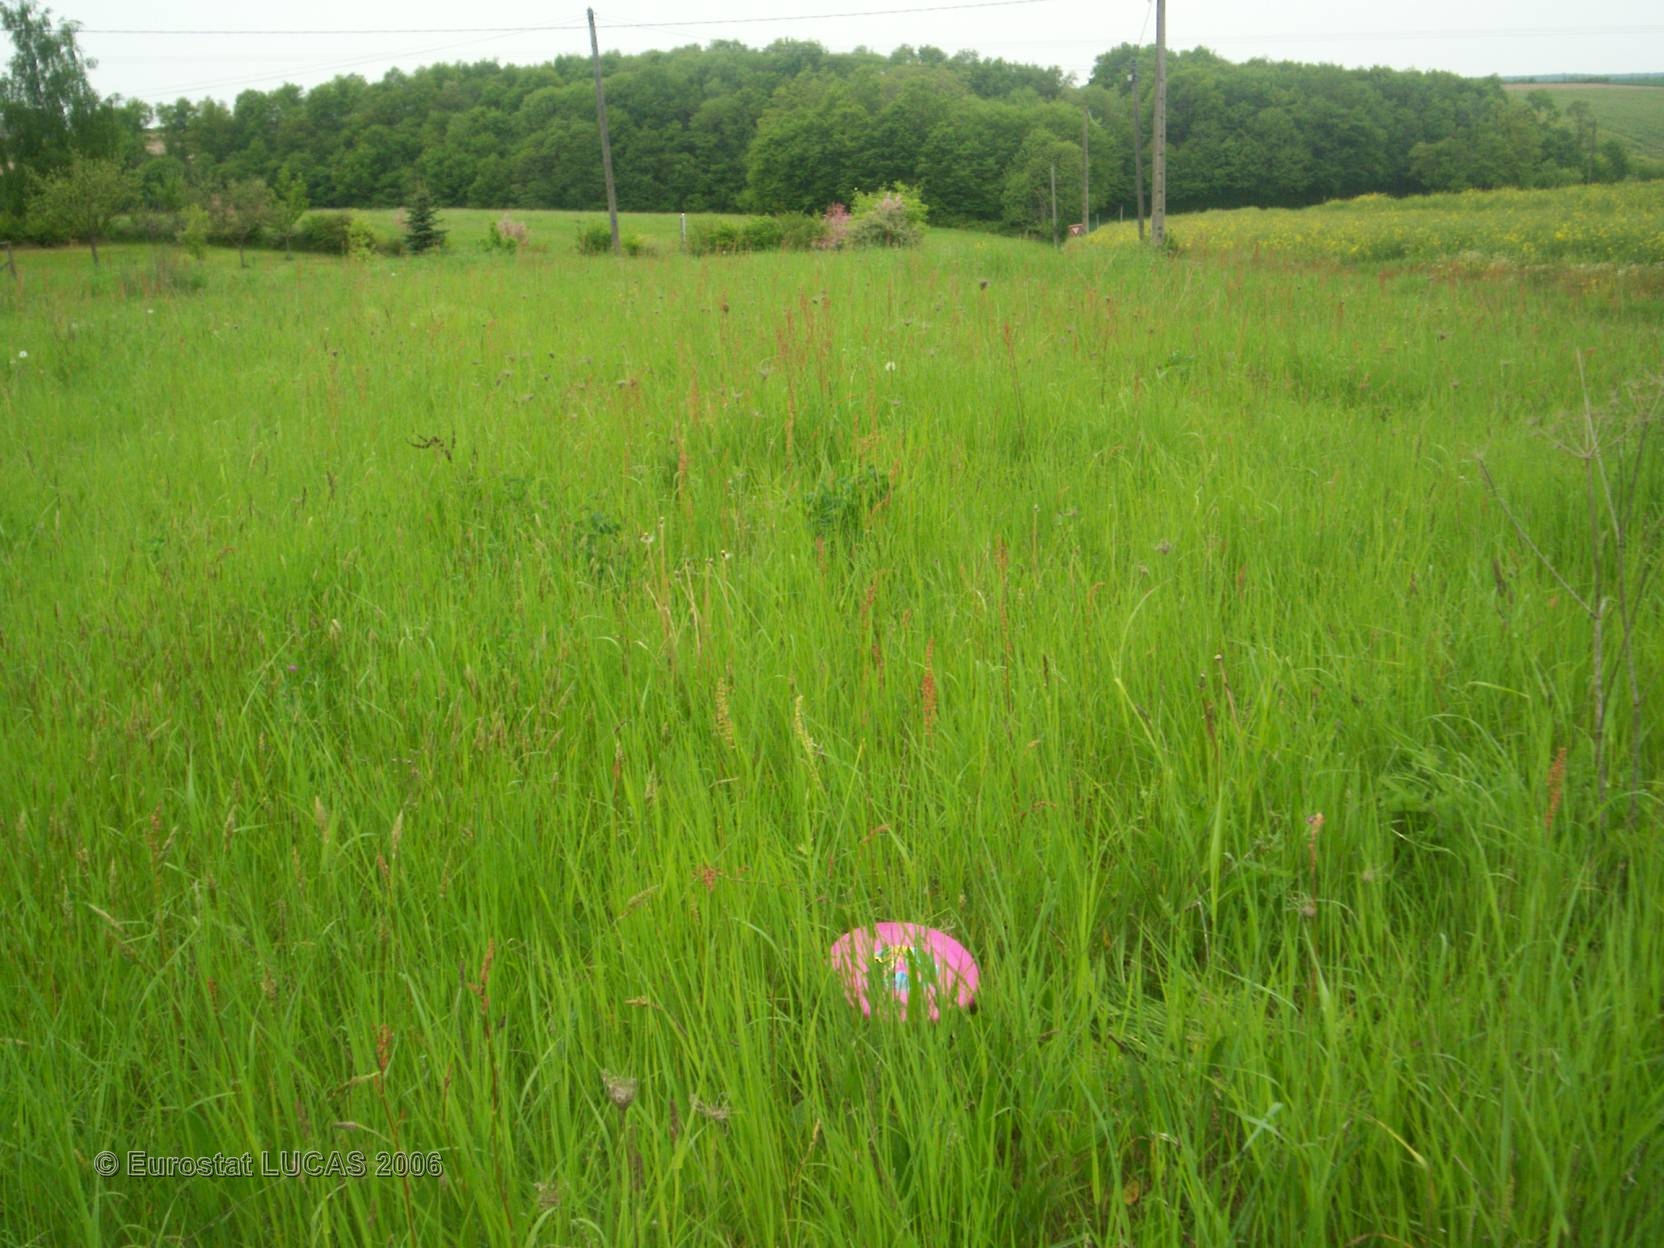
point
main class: Grassland
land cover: Grassland without tree/shrub cover
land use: Agriculture (excluding fallow land and kitchen gardens)
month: May
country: FR
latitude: 47.7373
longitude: 0.4694
